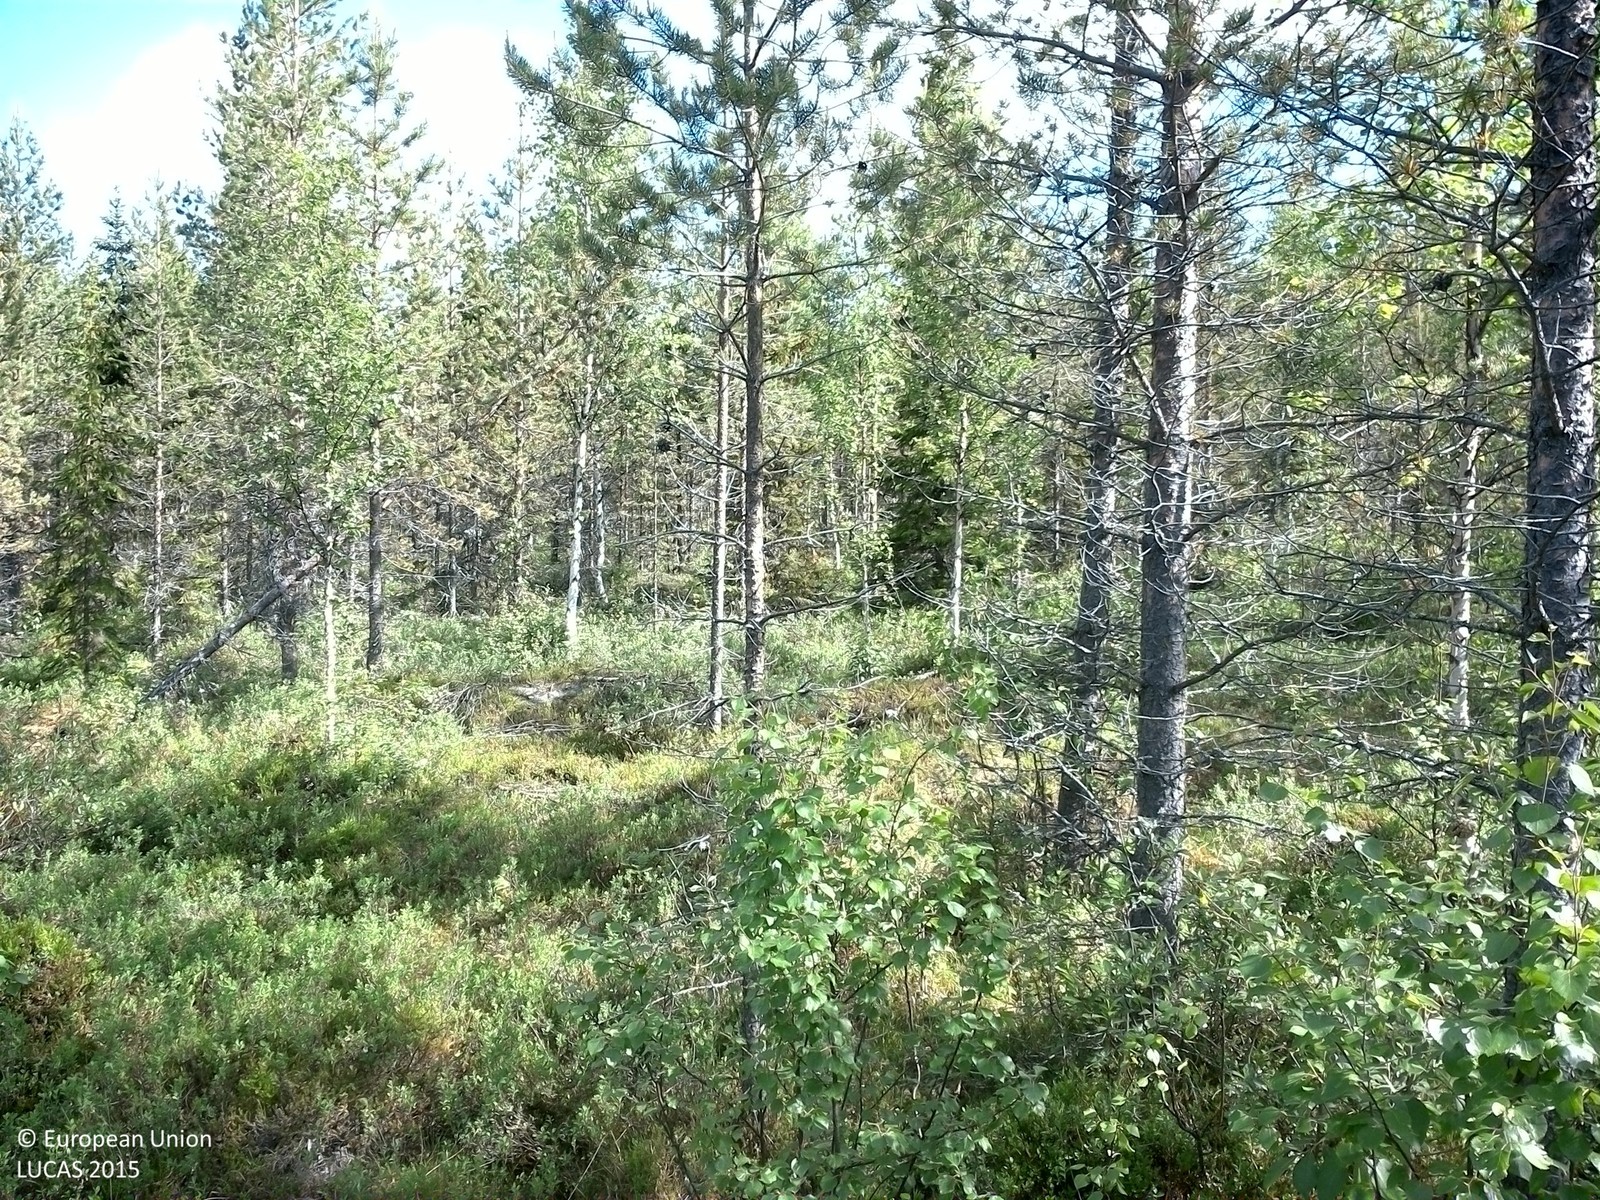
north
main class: Woodland
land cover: Pine dominated mixed woodland
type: boreal forest
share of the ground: 50 - 75 %
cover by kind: coniferous forest trees 40 %, shrubs 20 %, broadleaved forest trees 15 %, herbaceous plants 10 %, lichens and mosses 10 %, consolidated bare surface 5 %
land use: Forestry
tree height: < 5 m
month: July
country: SE
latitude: 64.3225
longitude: 16.8565
